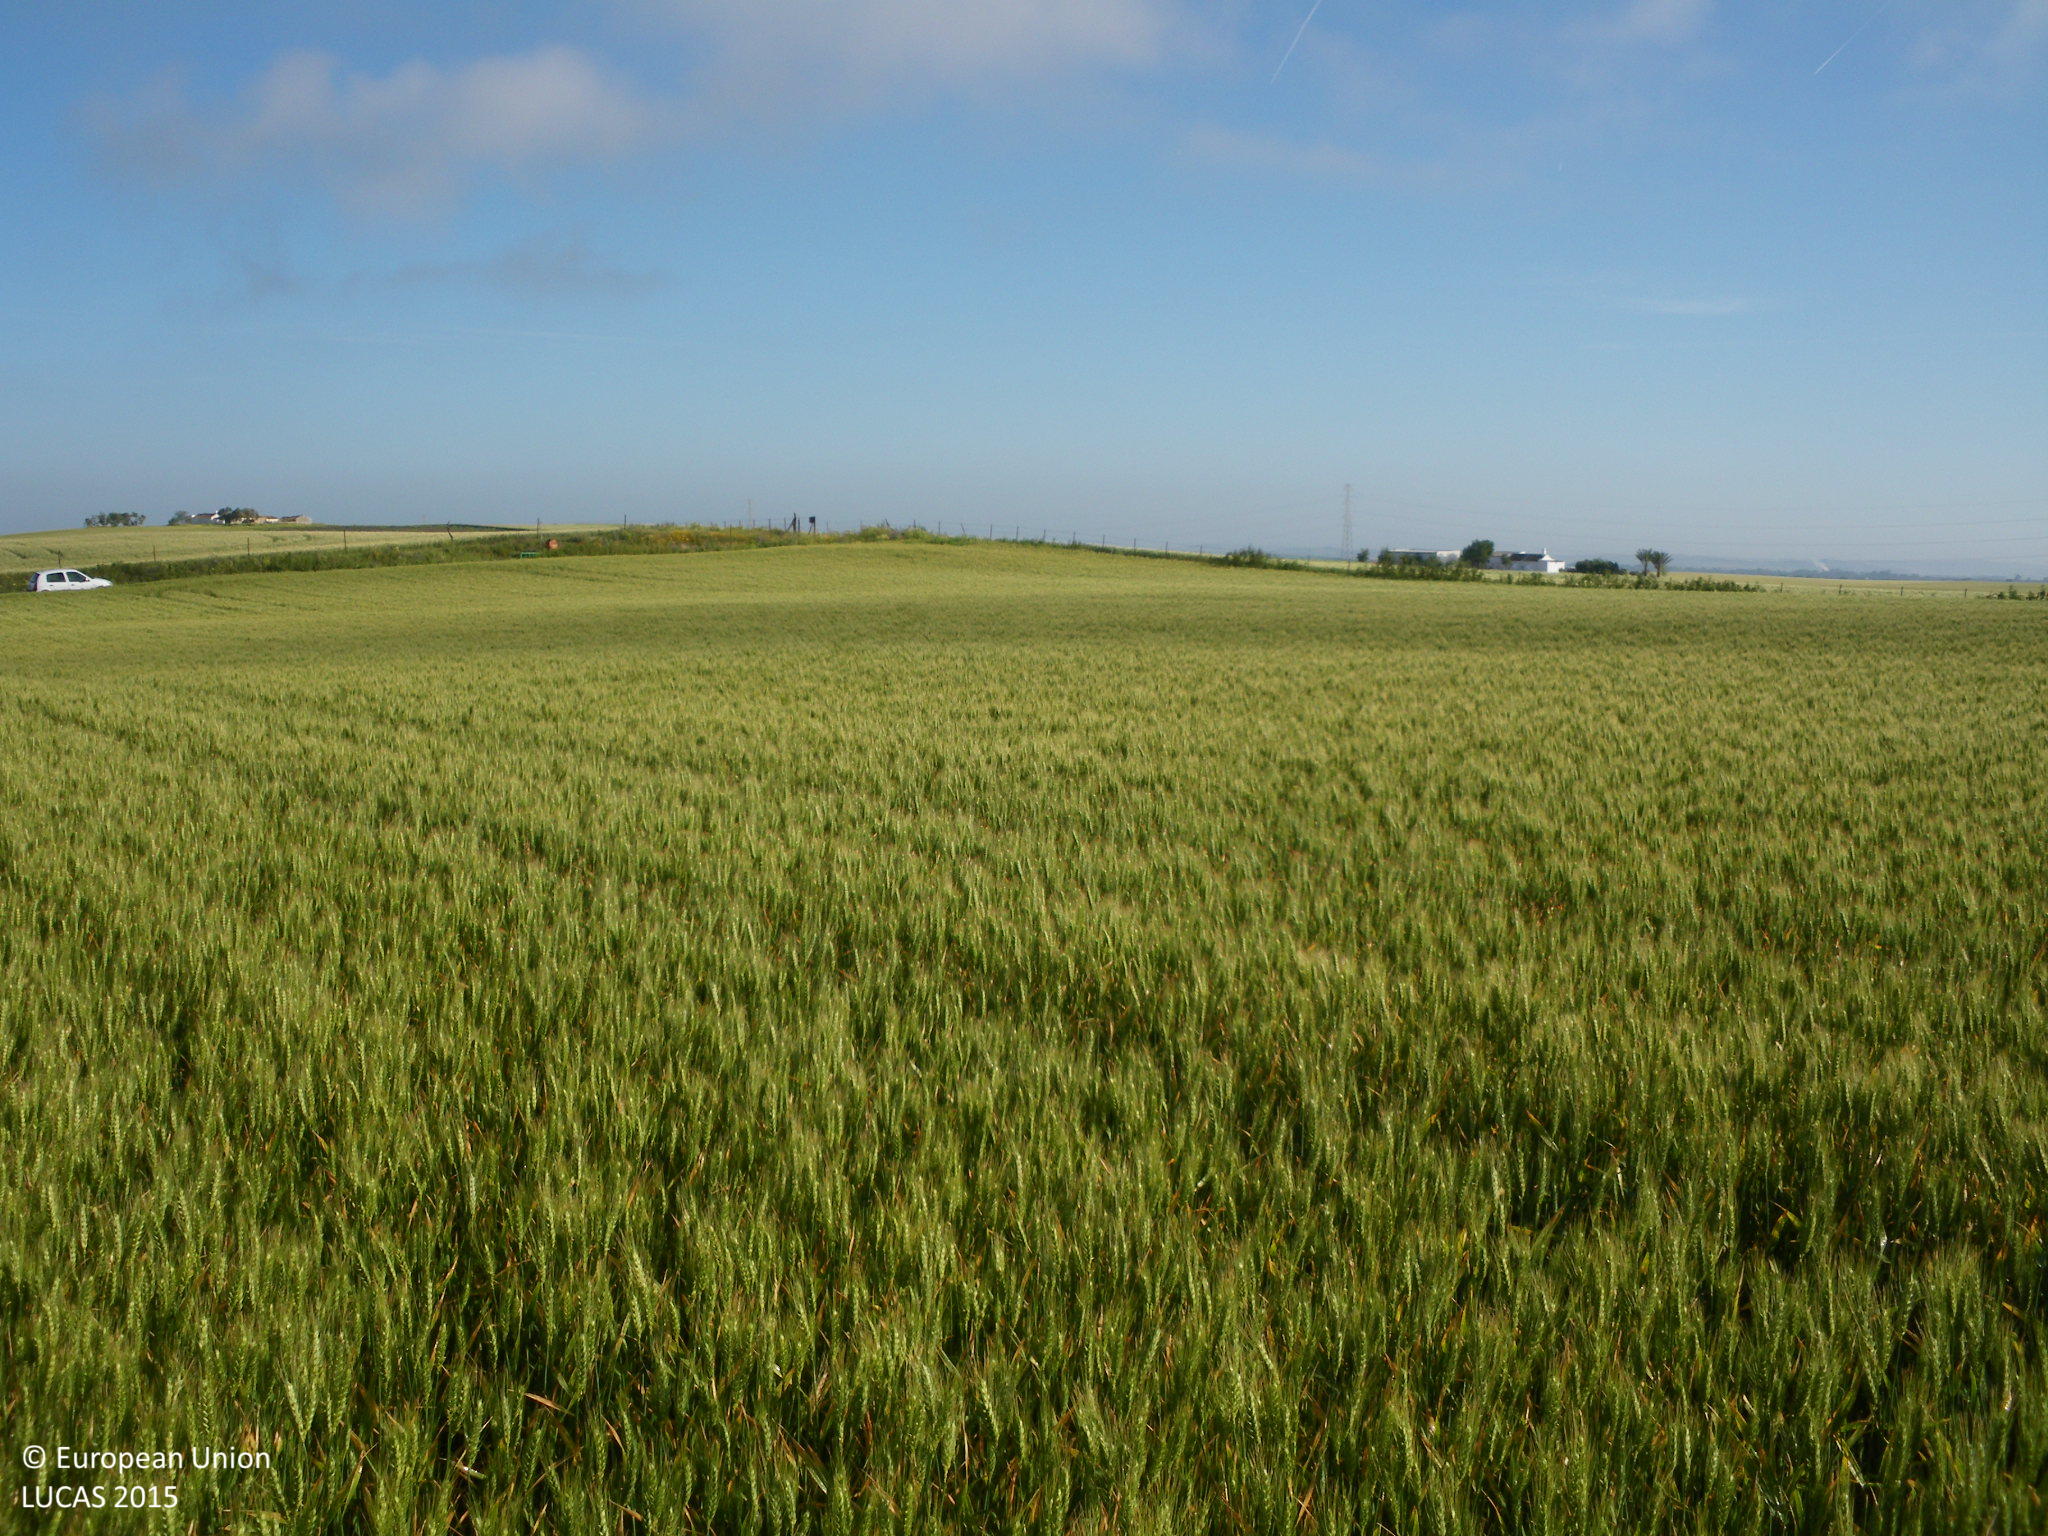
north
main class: Cropland
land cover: Common wheat
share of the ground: > 75 %
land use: Agriculture (excluding fallow land and kitchen gardens)
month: April
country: ES
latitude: 36.5691
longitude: -5.8847
